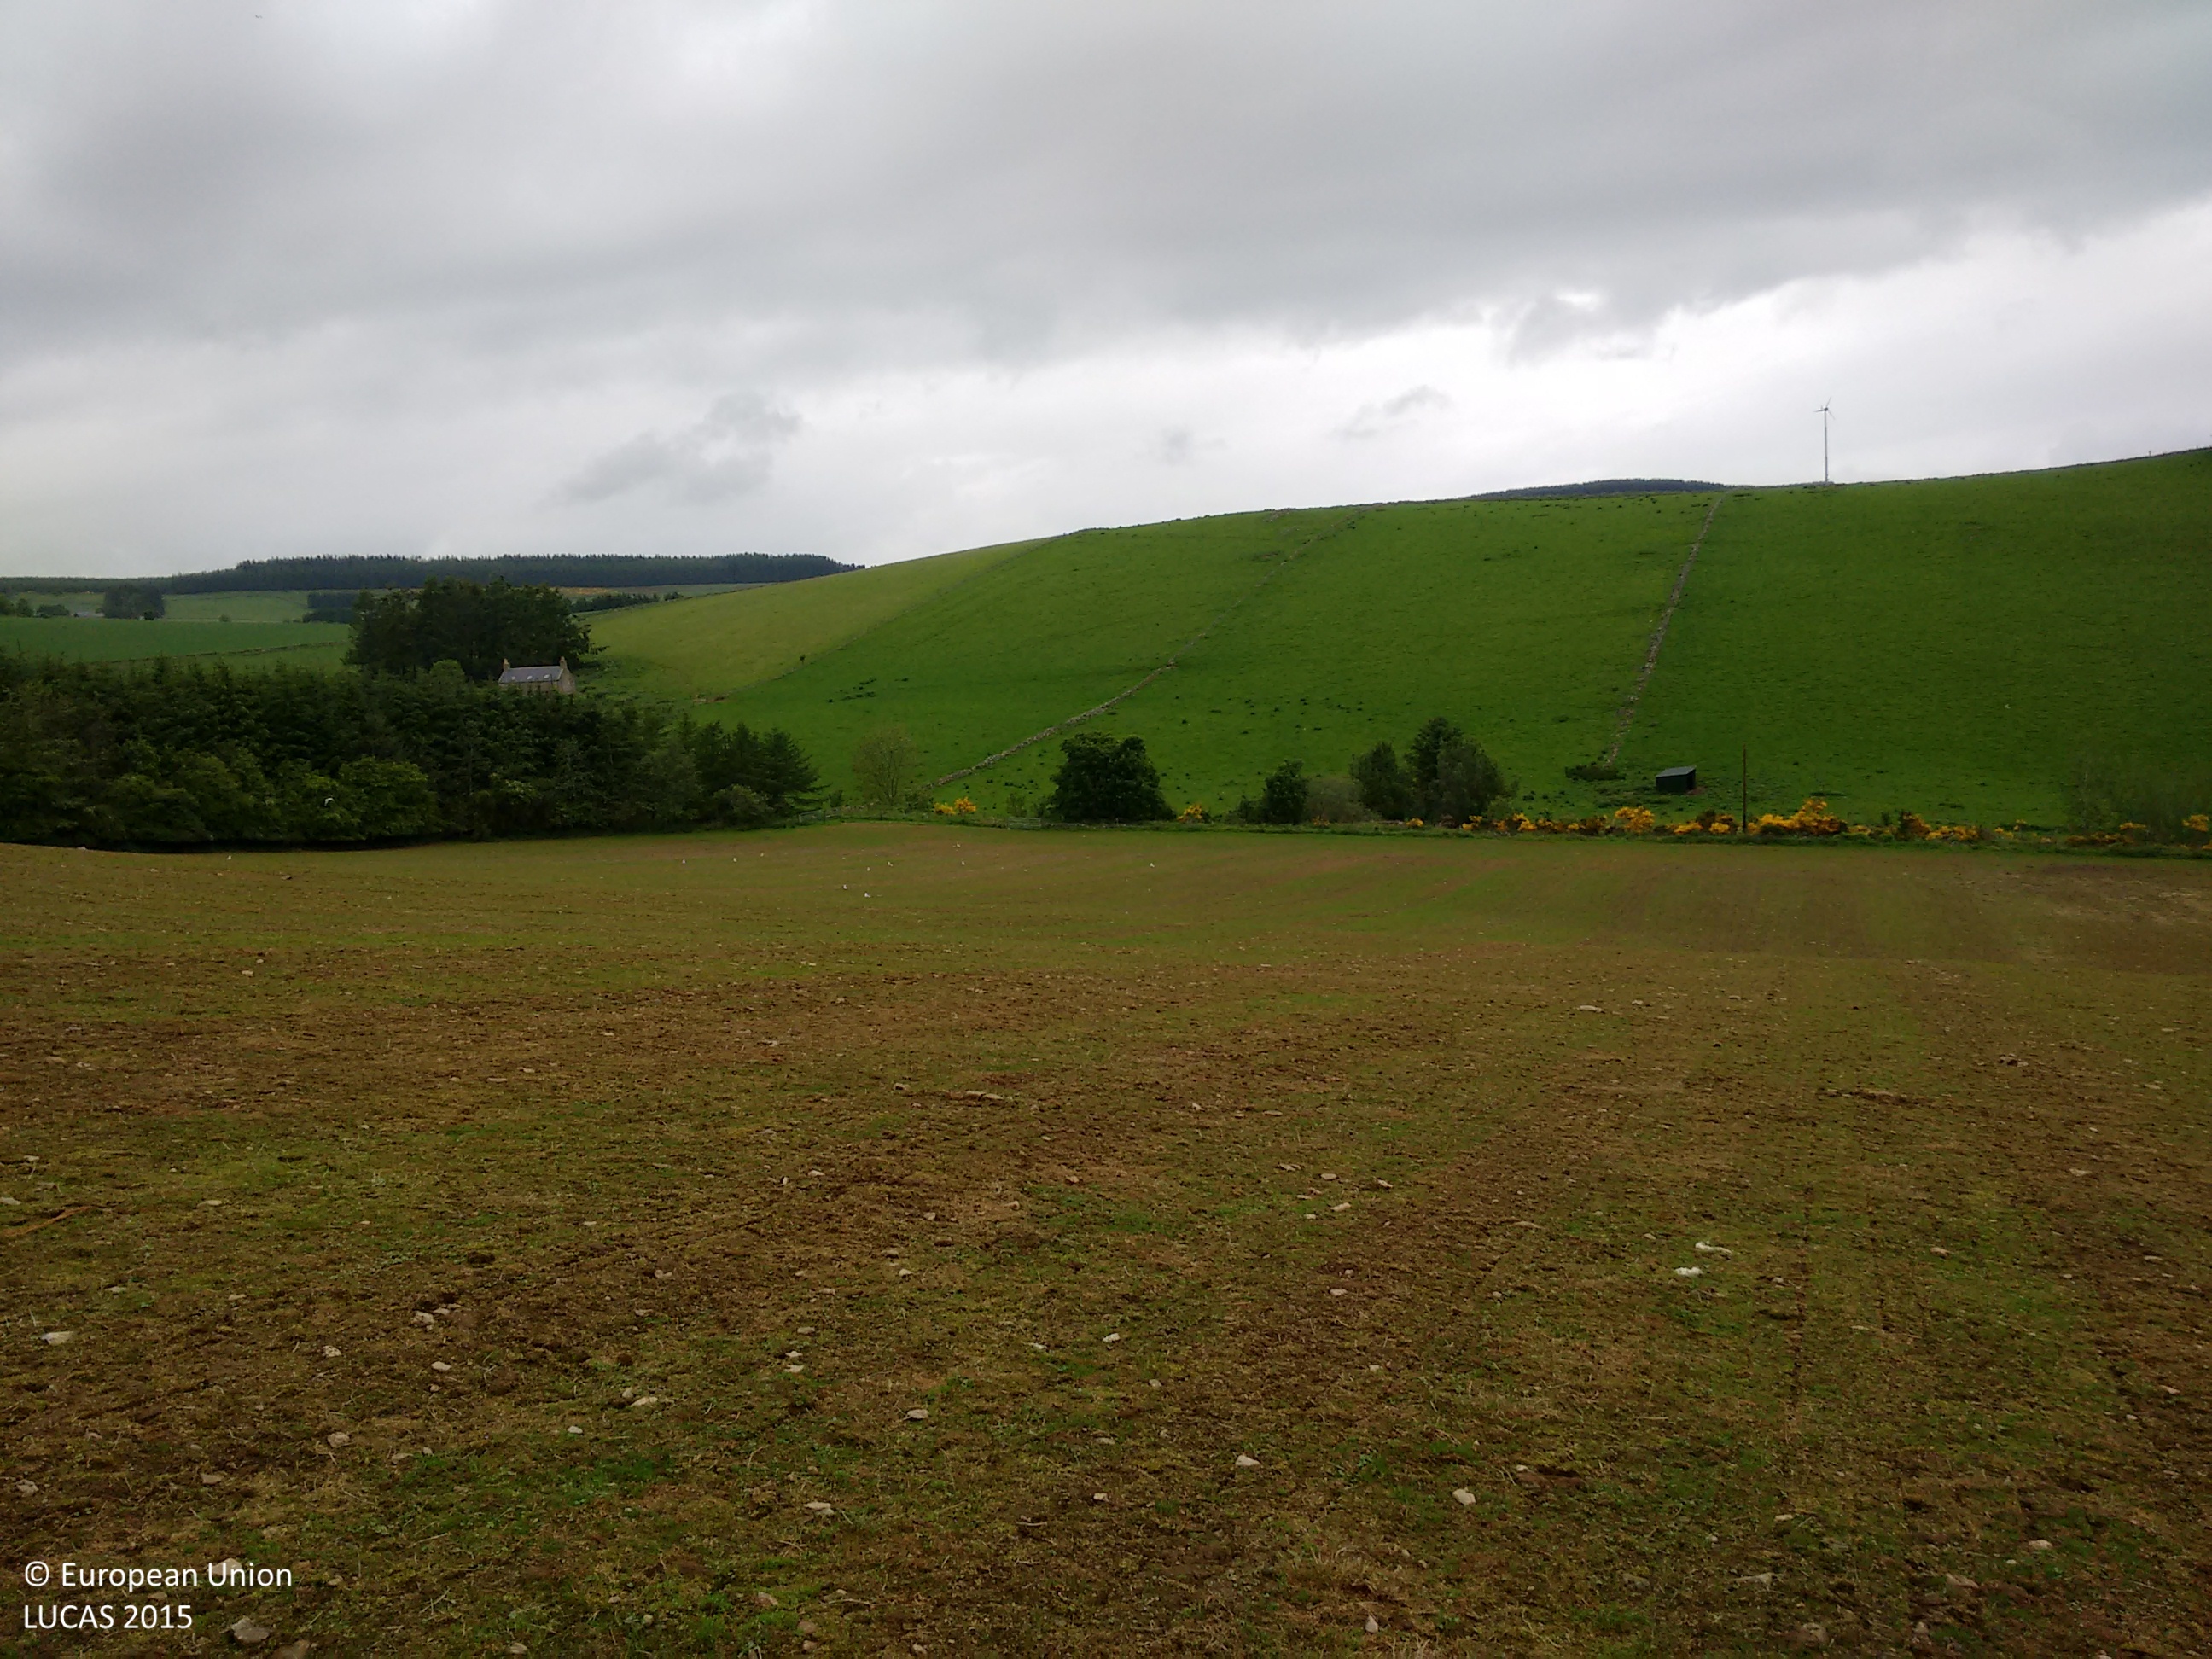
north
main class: Grassland
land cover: Grassland without tree/shrub cover
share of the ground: 25 - 50 %
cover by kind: herbaceous plants 60 %, unconsolidated bare surface 40 %
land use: Agriculture (excluding fallow land and kitchen gardens)
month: June
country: GB
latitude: 57.1831
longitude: -2.8150
